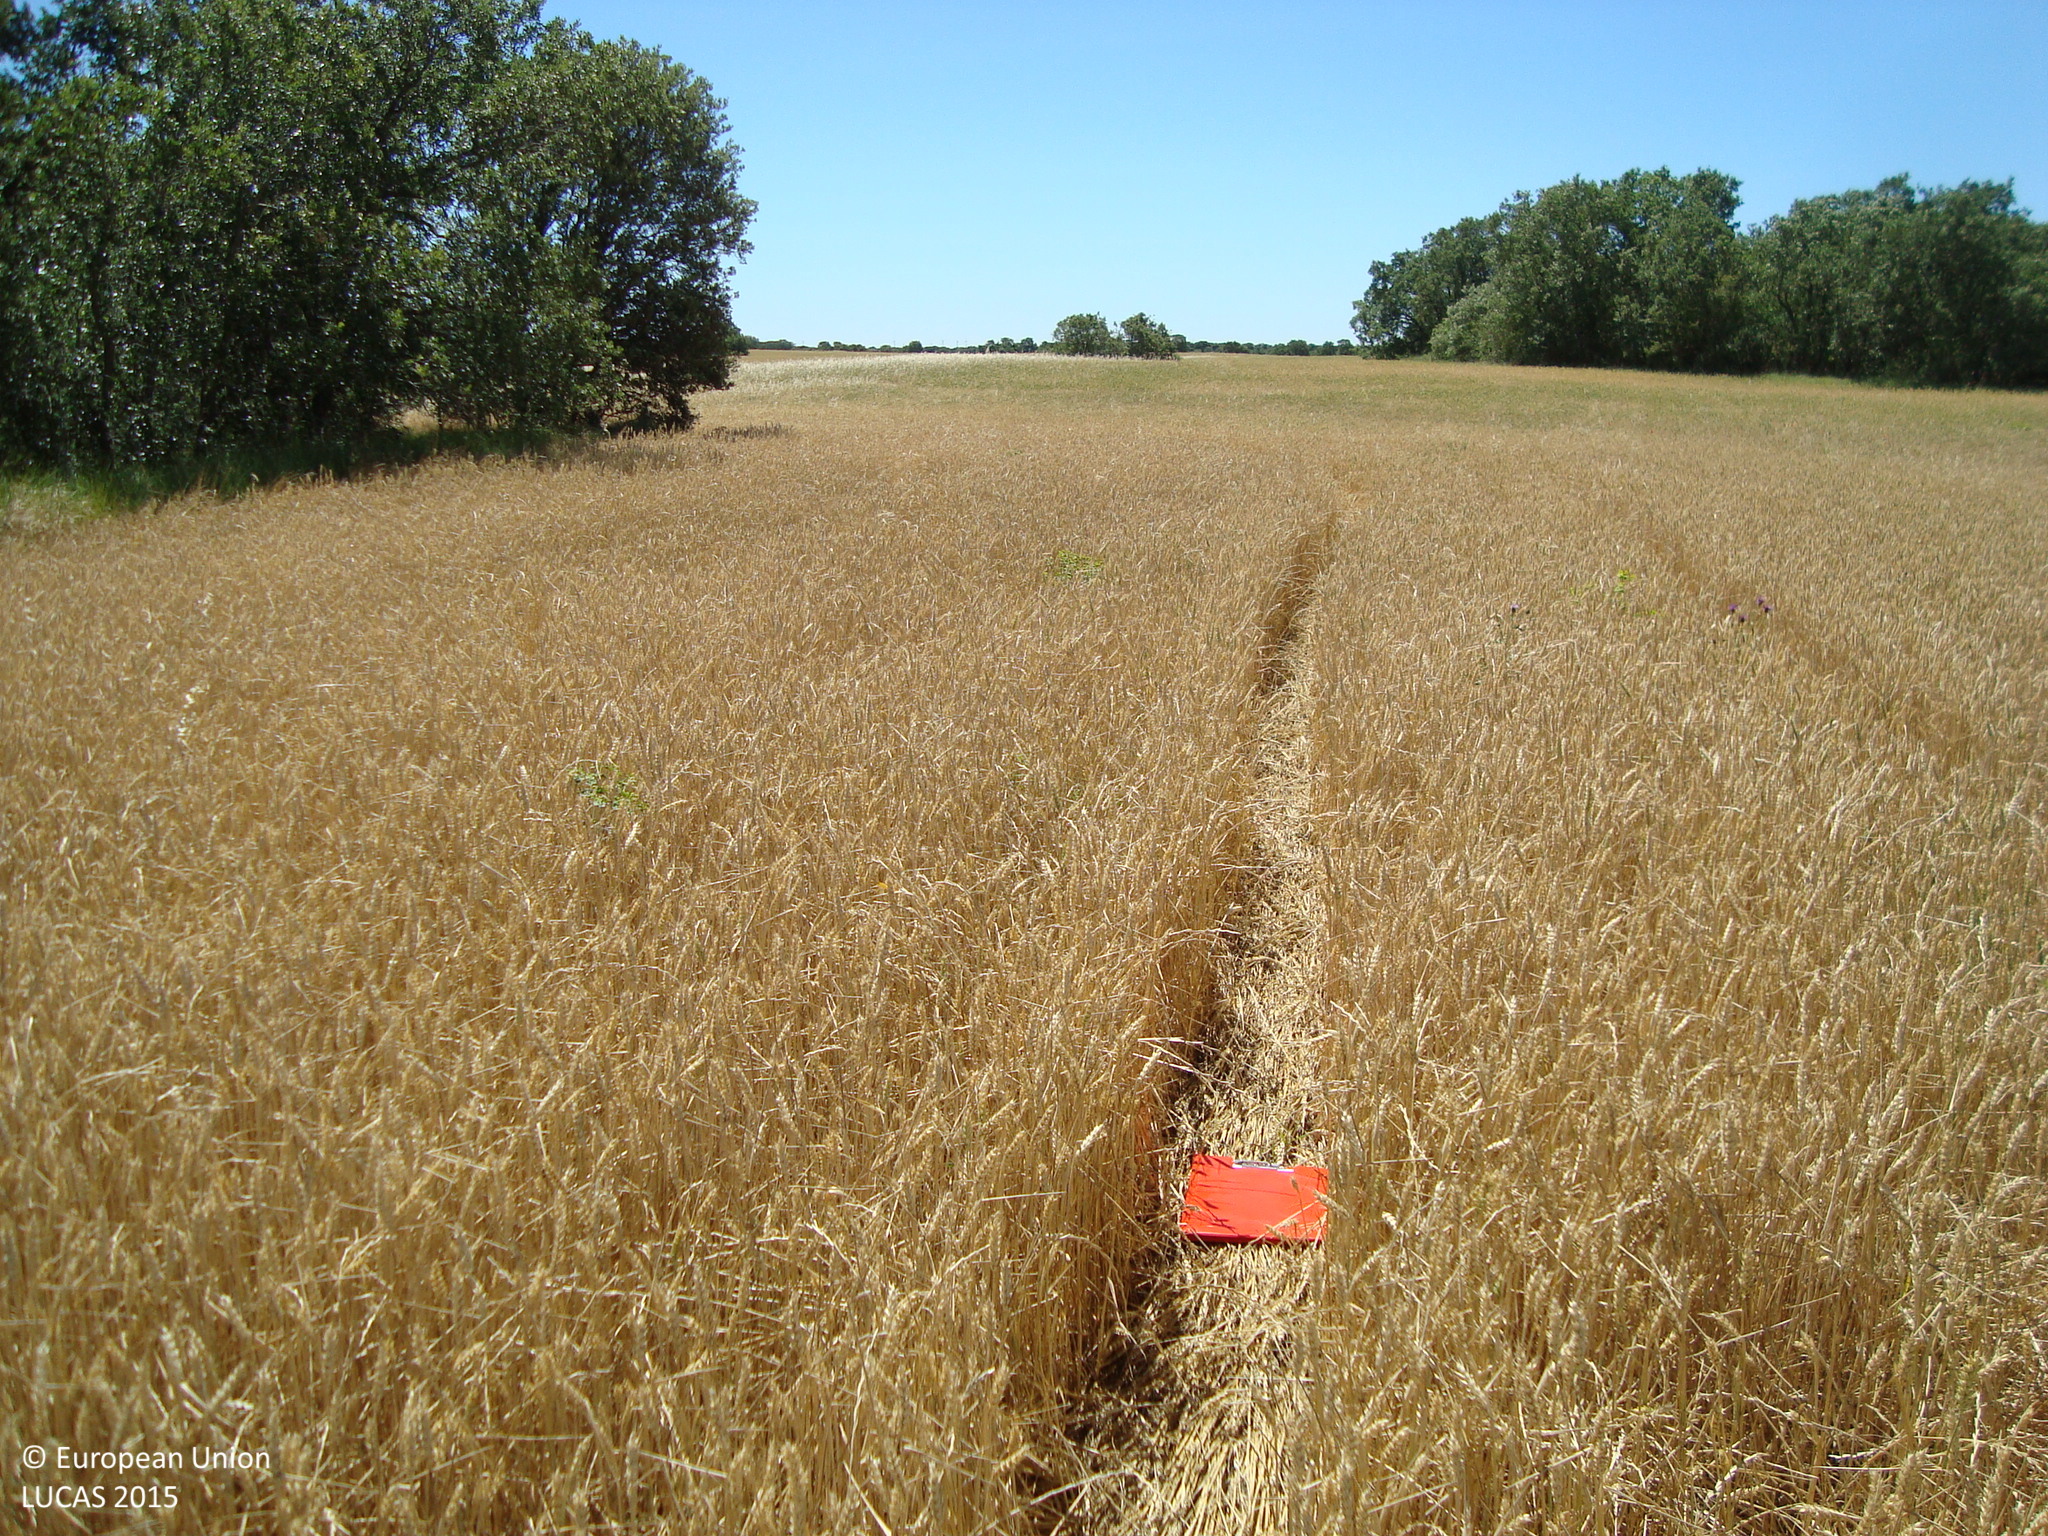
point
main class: Cropland
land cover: Common wheat
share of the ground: > 75 %
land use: Agriculture (excluding fallow land and kitchen gardens)
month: June
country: ES
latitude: 42.1059
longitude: -4.3253
